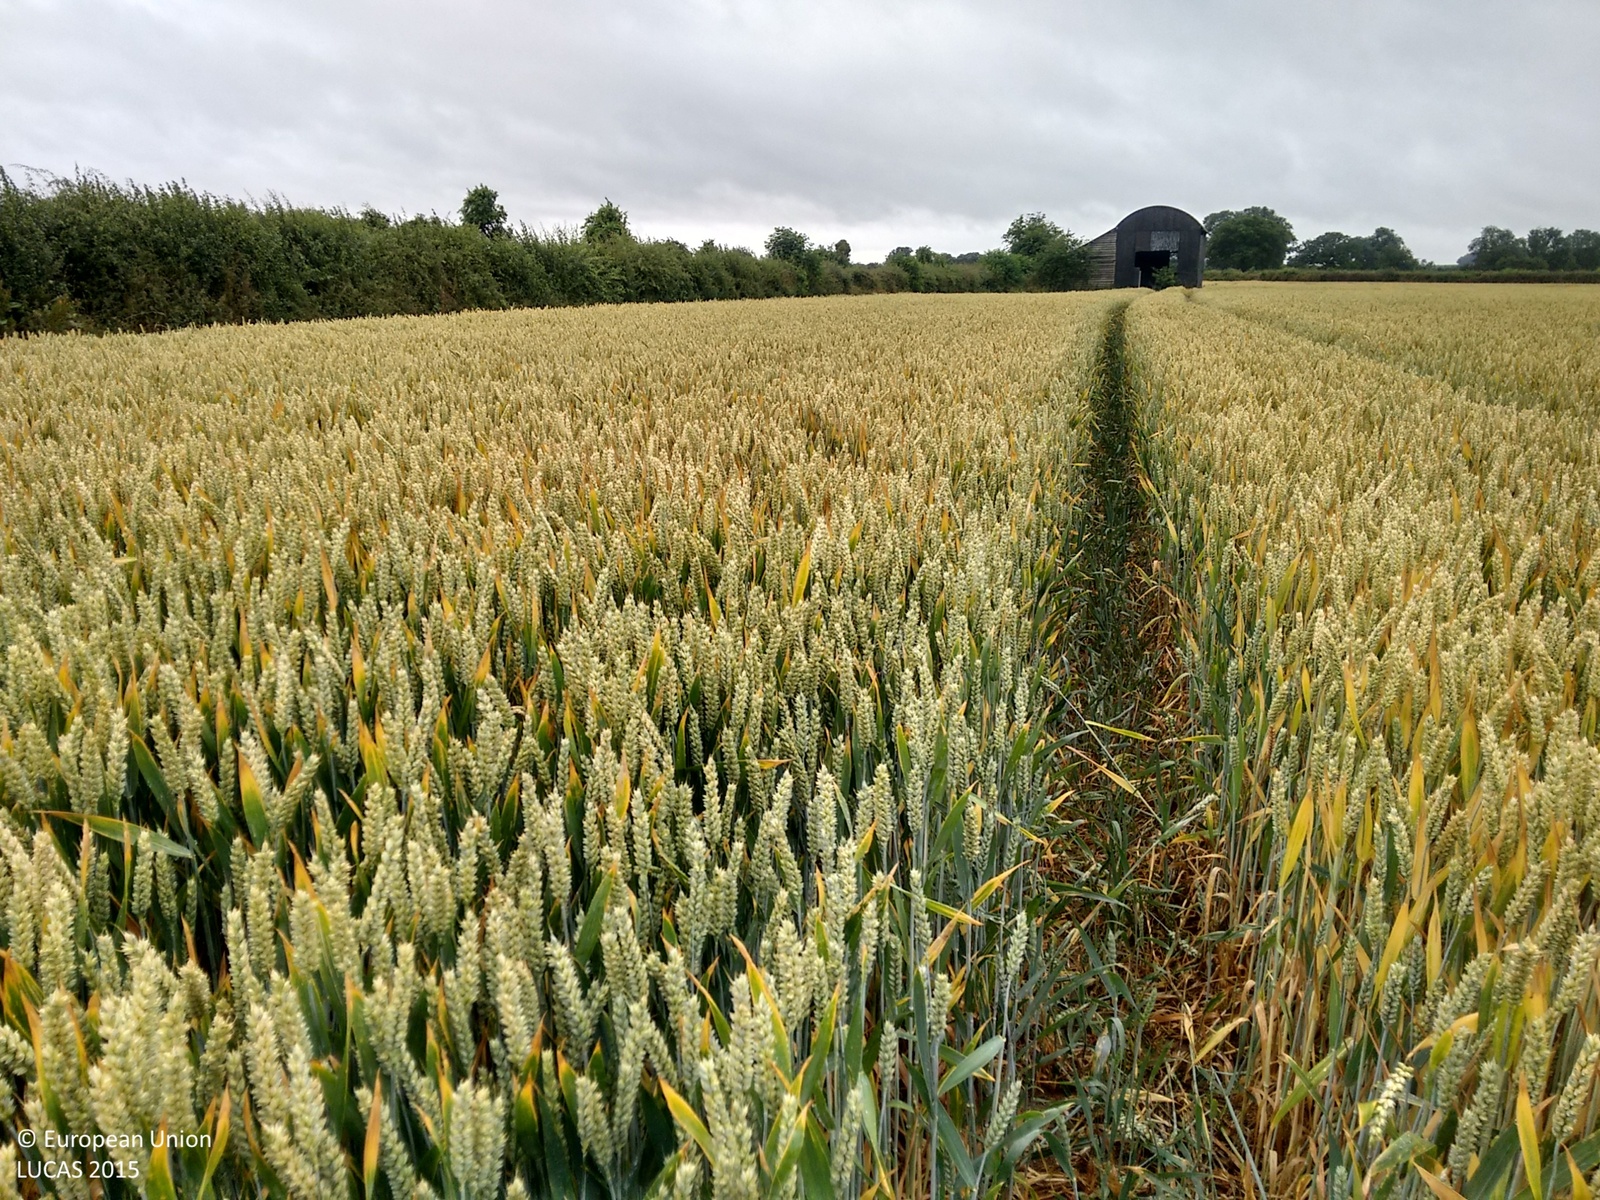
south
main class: Cropland
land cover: Common wheat
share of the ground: > 75 %
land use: Agriculture (excluding fallow land and kitchen gardens)
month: July
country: GB
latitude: 52.2601
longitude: -2.8331
